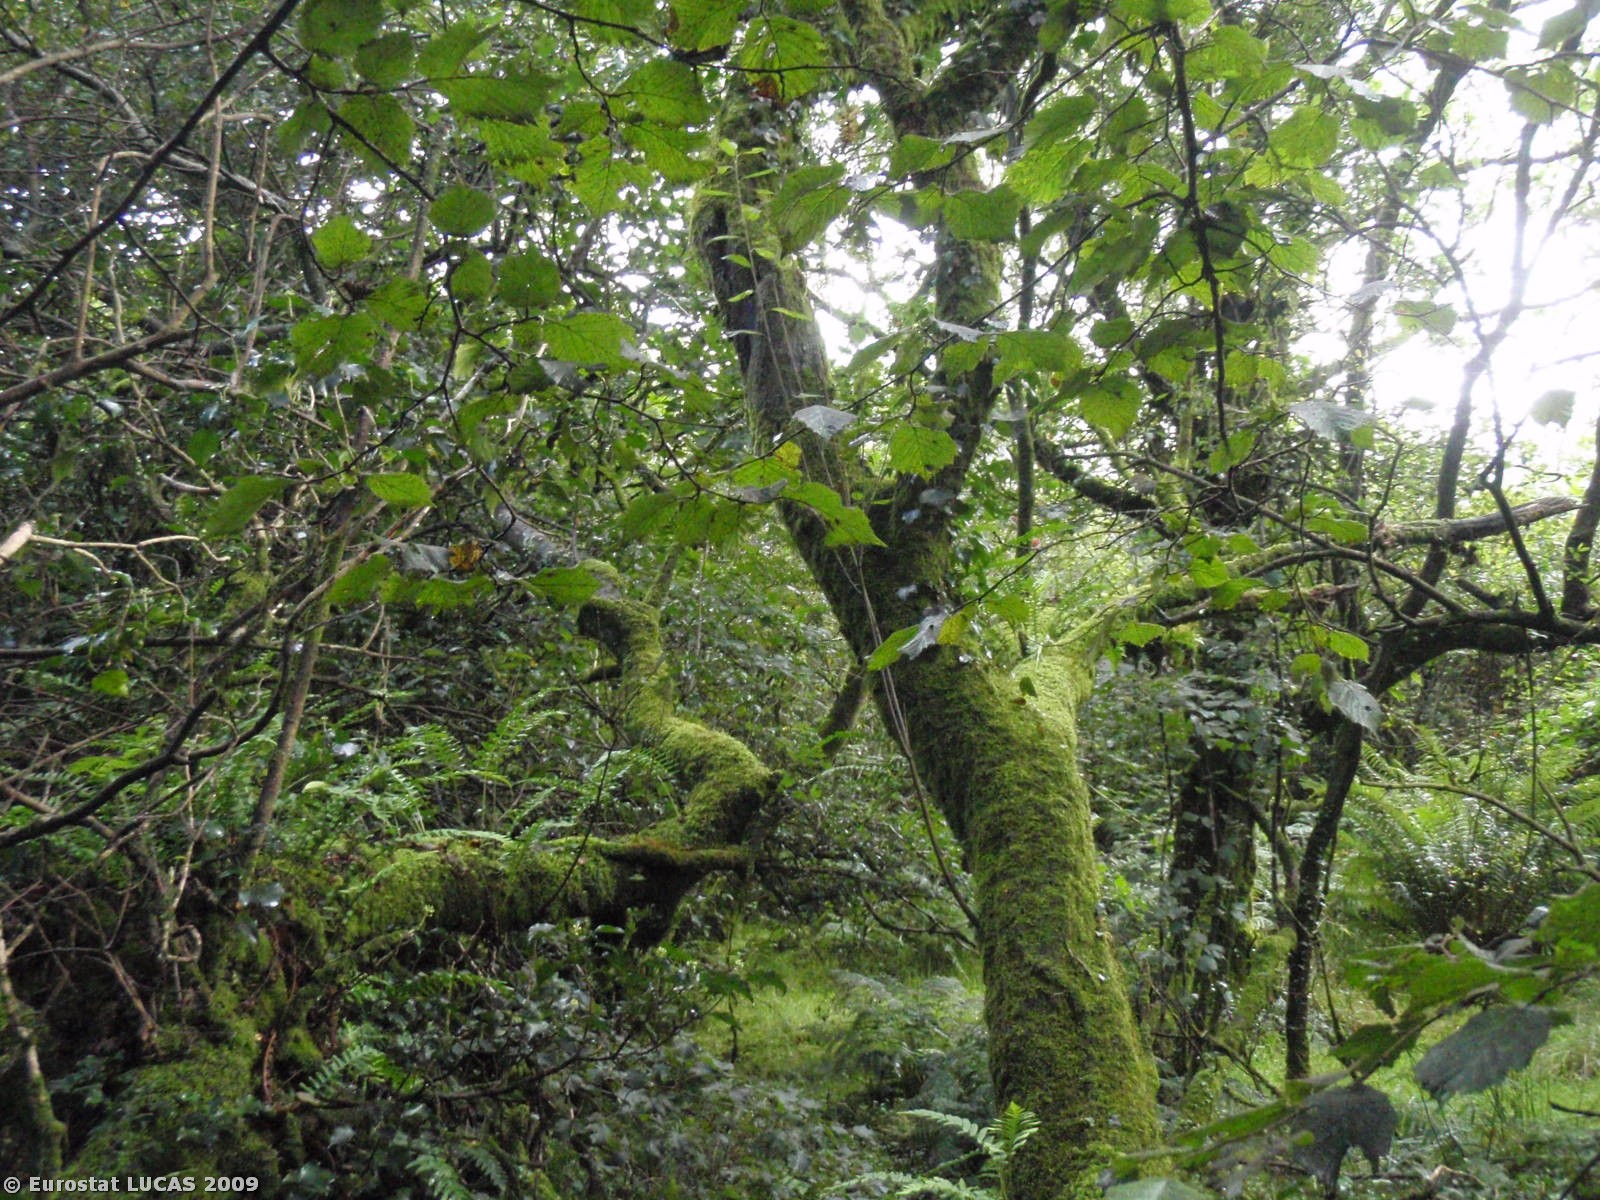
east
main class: Woodland
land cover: Broadleaved woodland
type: floodplain forest
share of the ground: > 75 %
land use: Unused
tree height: > 5 m
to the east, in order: Broadleaved woodland; Grassland without tree/shrub cover; Broadleaved woodland; Grassland without tree/shrub cover; Broadleaved woodland; Grassland without tree/shrub cover; Managed hedges; Grassland without tree/shrub cover
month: August
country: GB
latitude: 50.9265
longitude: -4.4011
